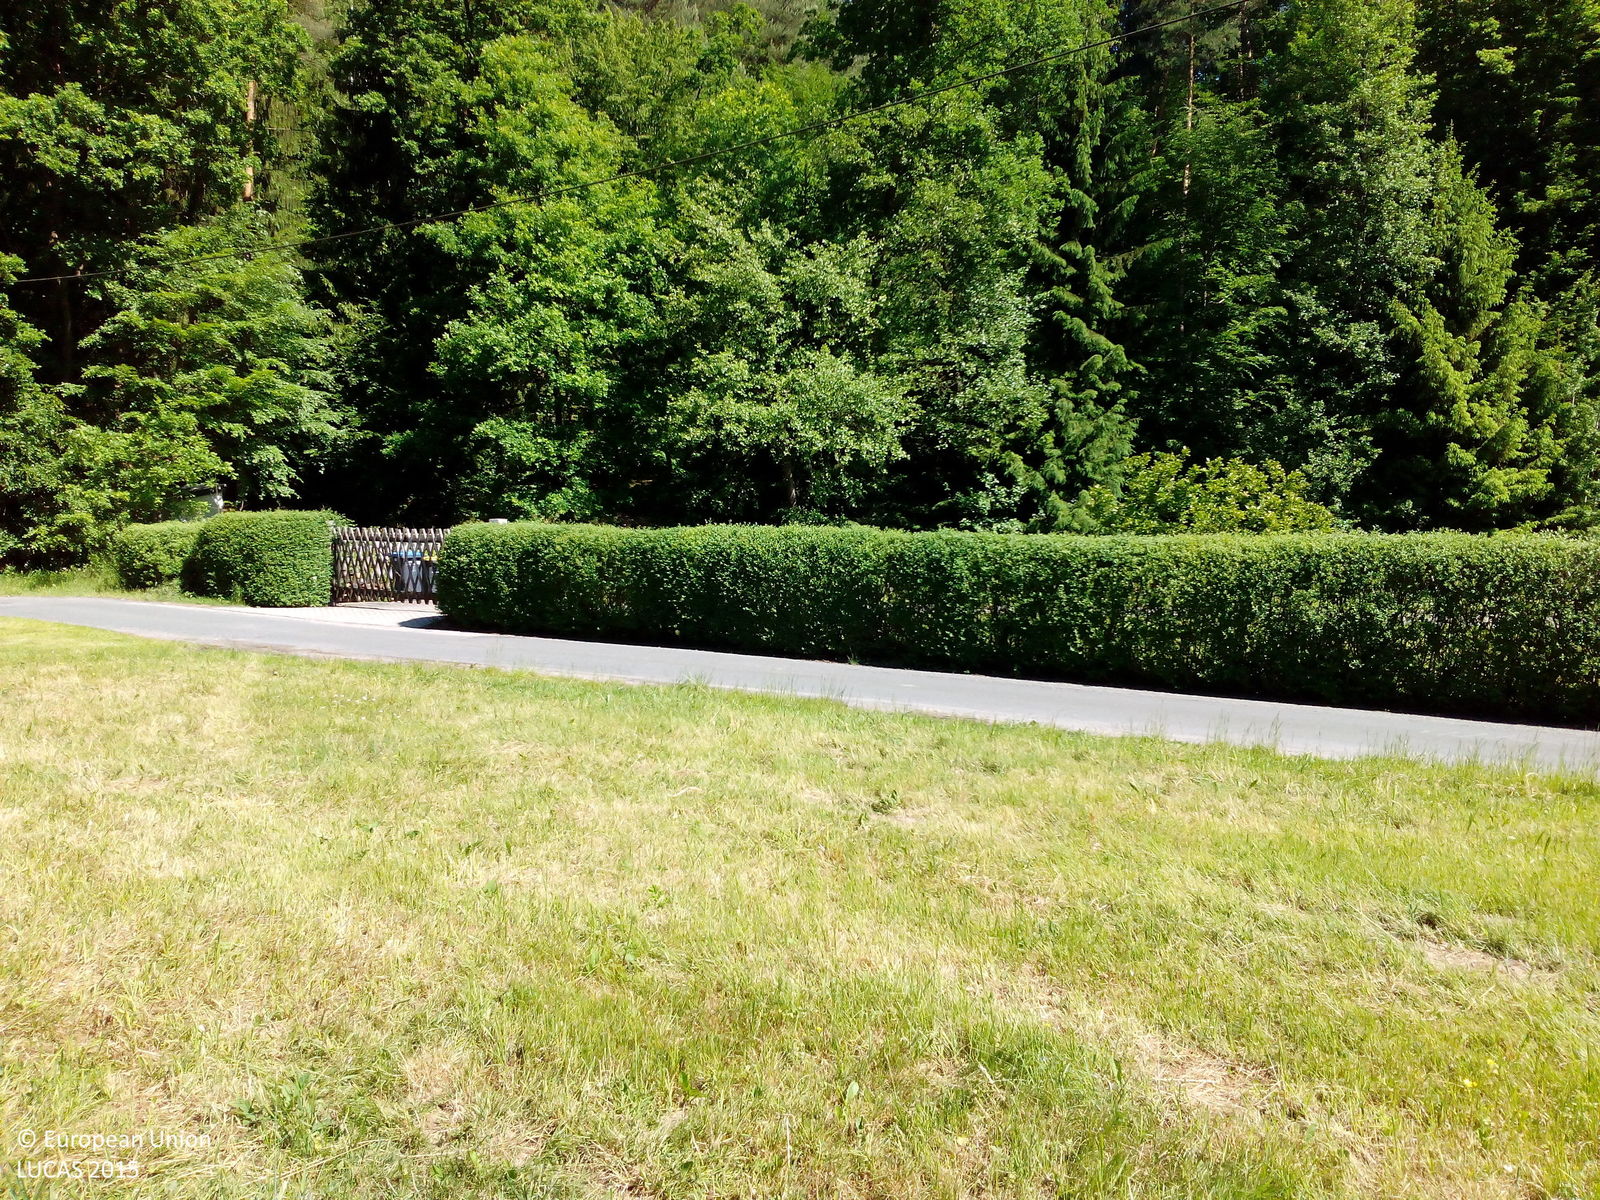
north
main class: Grassland
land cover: Grassland without tree/shrub cover
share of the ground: > 75 %
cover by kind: herbaceous plants 100 %
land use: Agriculture (excluding fallow land and kitchen gardens)
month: June
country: DE
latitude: 50.7844
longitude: 11.6024
